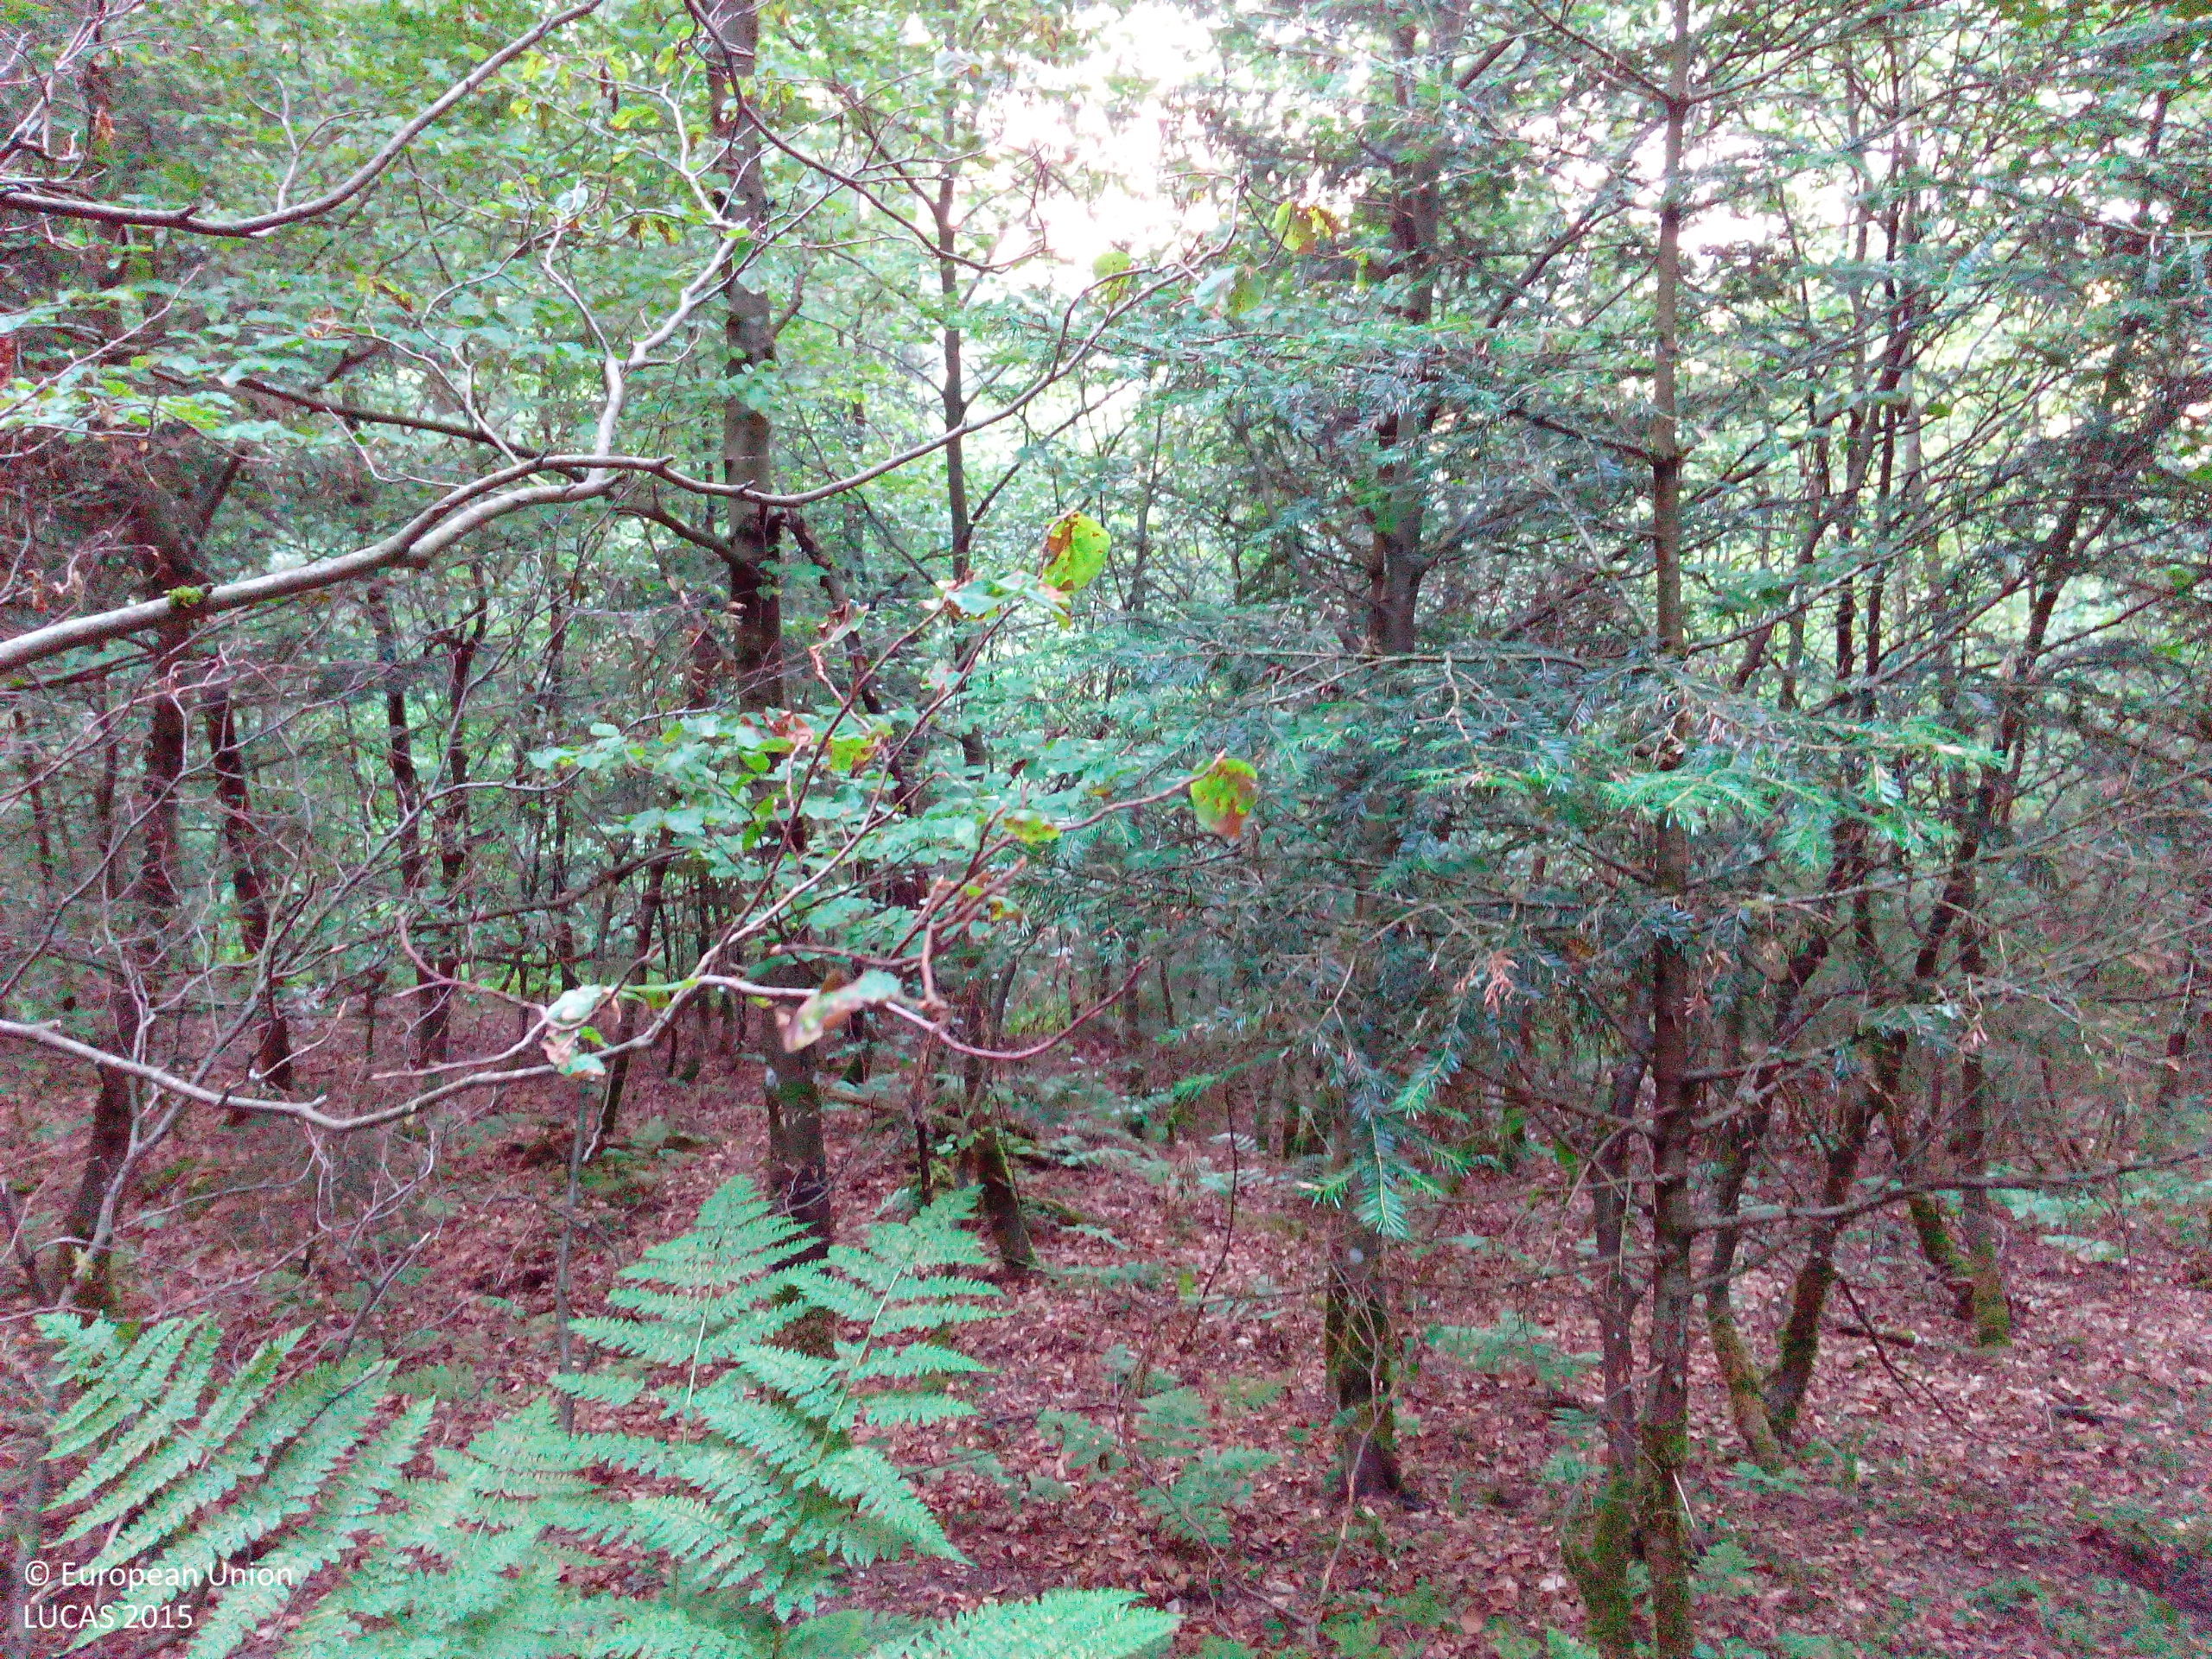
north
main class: Woodland
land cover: Other mixed woodland
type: beech forest
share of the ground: > 75 %
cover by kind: coniferous forest trees 50 %, broadleaved forest trees 35 %, herbaceous plants 5 %, lichens and mosses 5 %, unconsolidated bare surface 5 %
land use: Forestry
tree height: > 5 m
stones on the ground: < 10 %
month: August
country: DE
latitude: 47.9028
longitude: 8.1952
